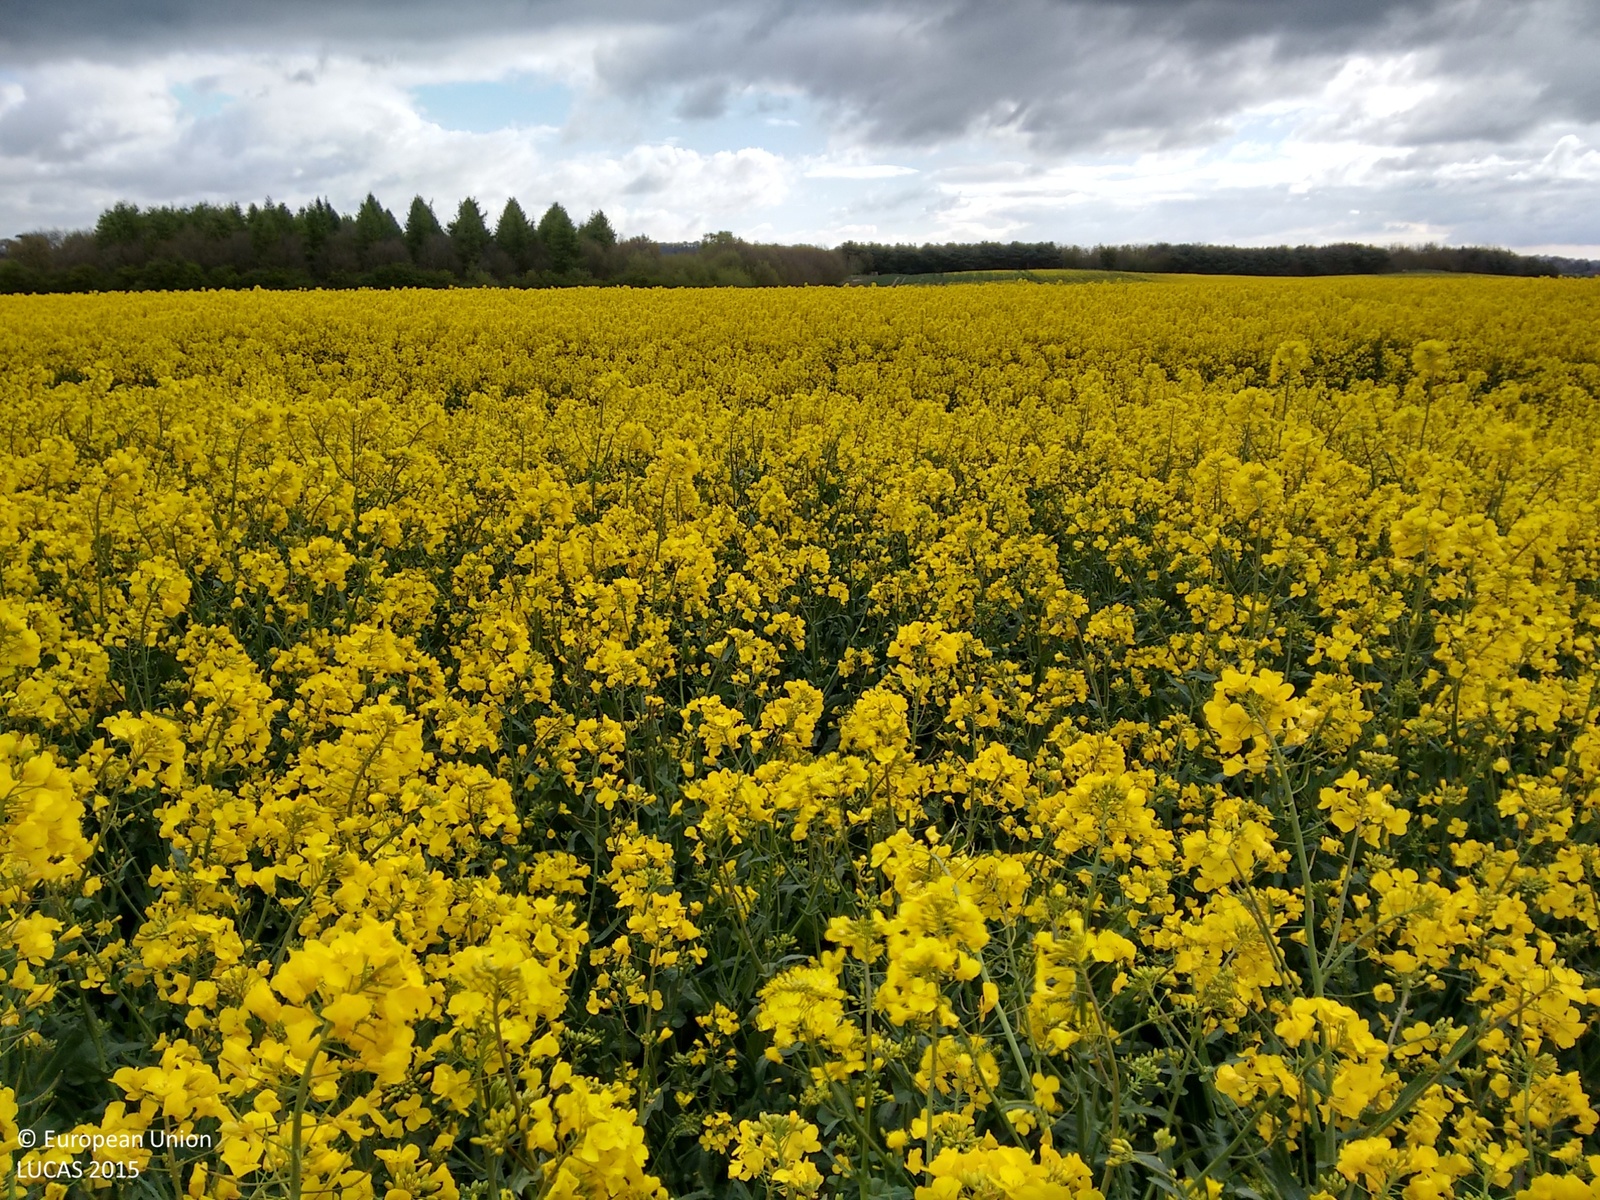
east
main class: Cropland
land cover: Rape and turnip rape
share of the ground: > 75 %
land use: Agriculture (excluding fallow land and kitchen gardens)
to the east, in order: Rape and turnip rape
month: April
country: GB
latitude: 53.2232
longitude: 0.0077
